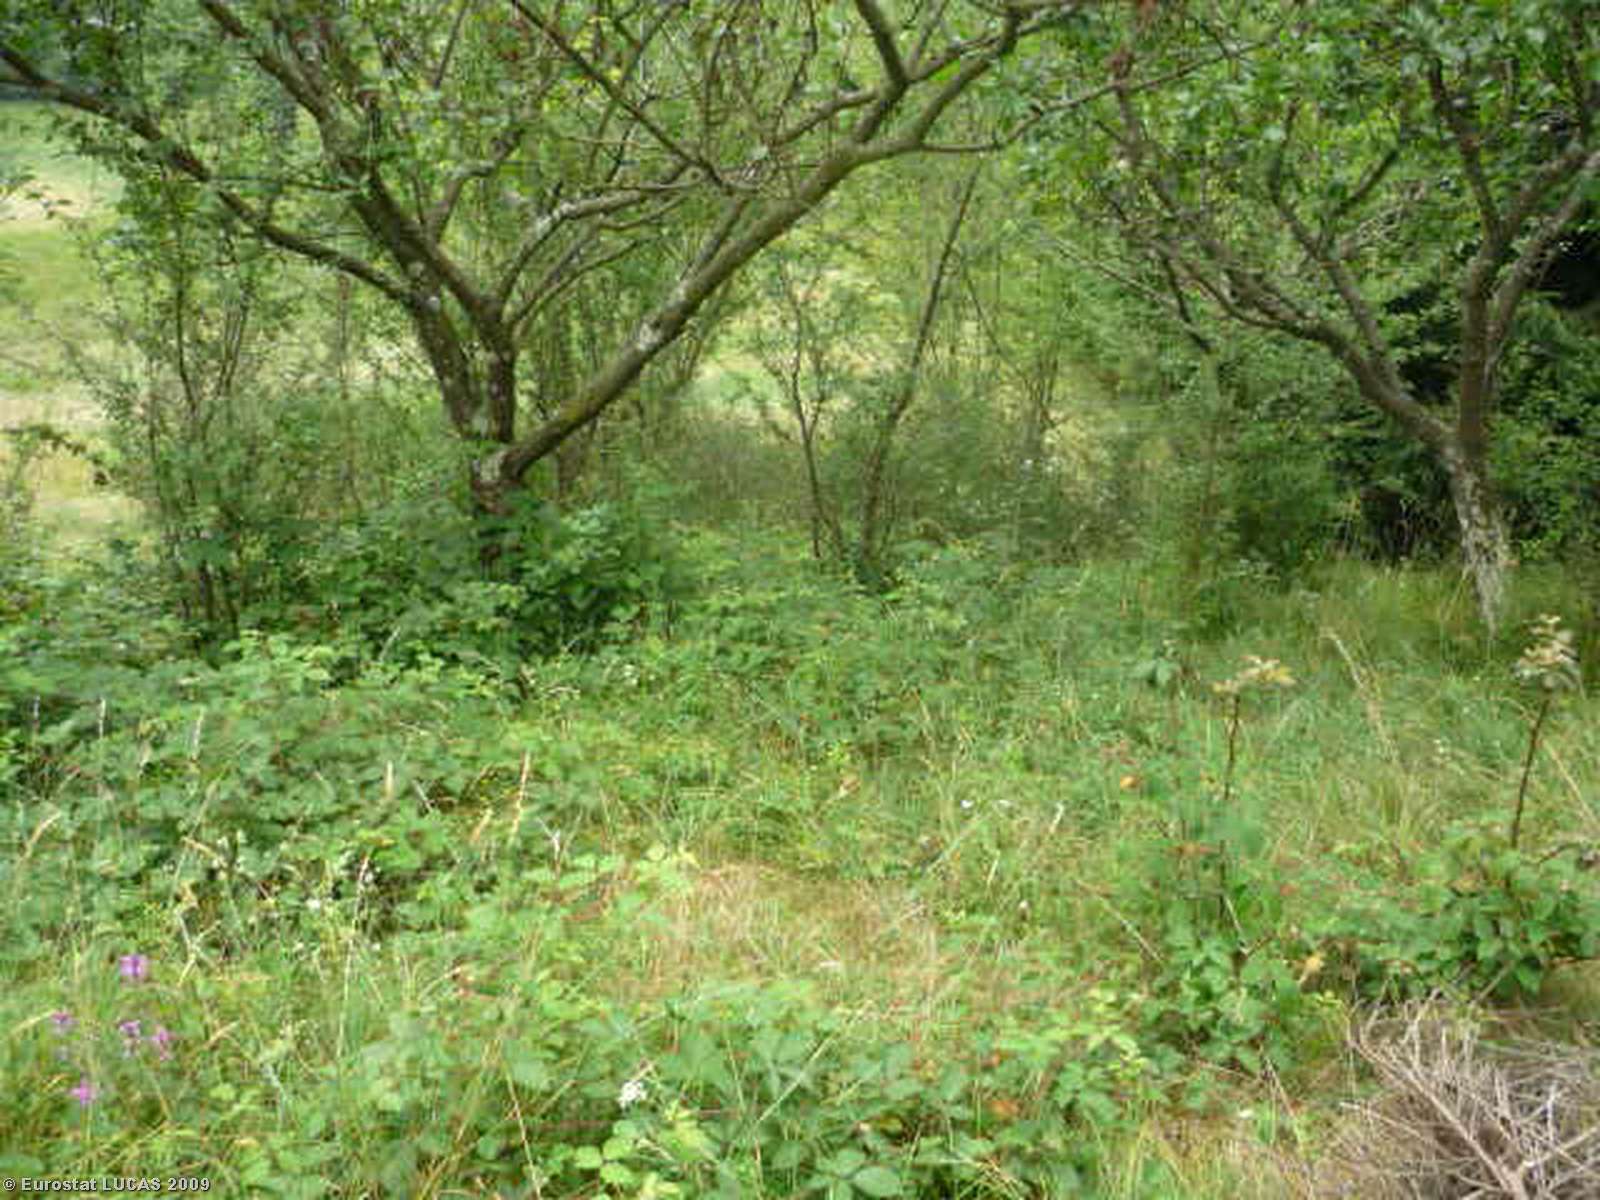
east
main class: Woodland
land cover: Broadleaved woodland
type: thermophilous deciduous forest
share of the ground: > 75 %
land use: Forestry
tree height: > 5 m
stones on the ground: < 10 %
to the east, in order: Broadleaved woodland; Grassland with sparse tree/shrub cover; Artificial constructions; Paved roads, cycling and walking lanes; Grass margins; Mixed woodland; Artificial constructions in urban areas
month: July
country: IT
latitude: 45.6314
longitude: 8.0916
